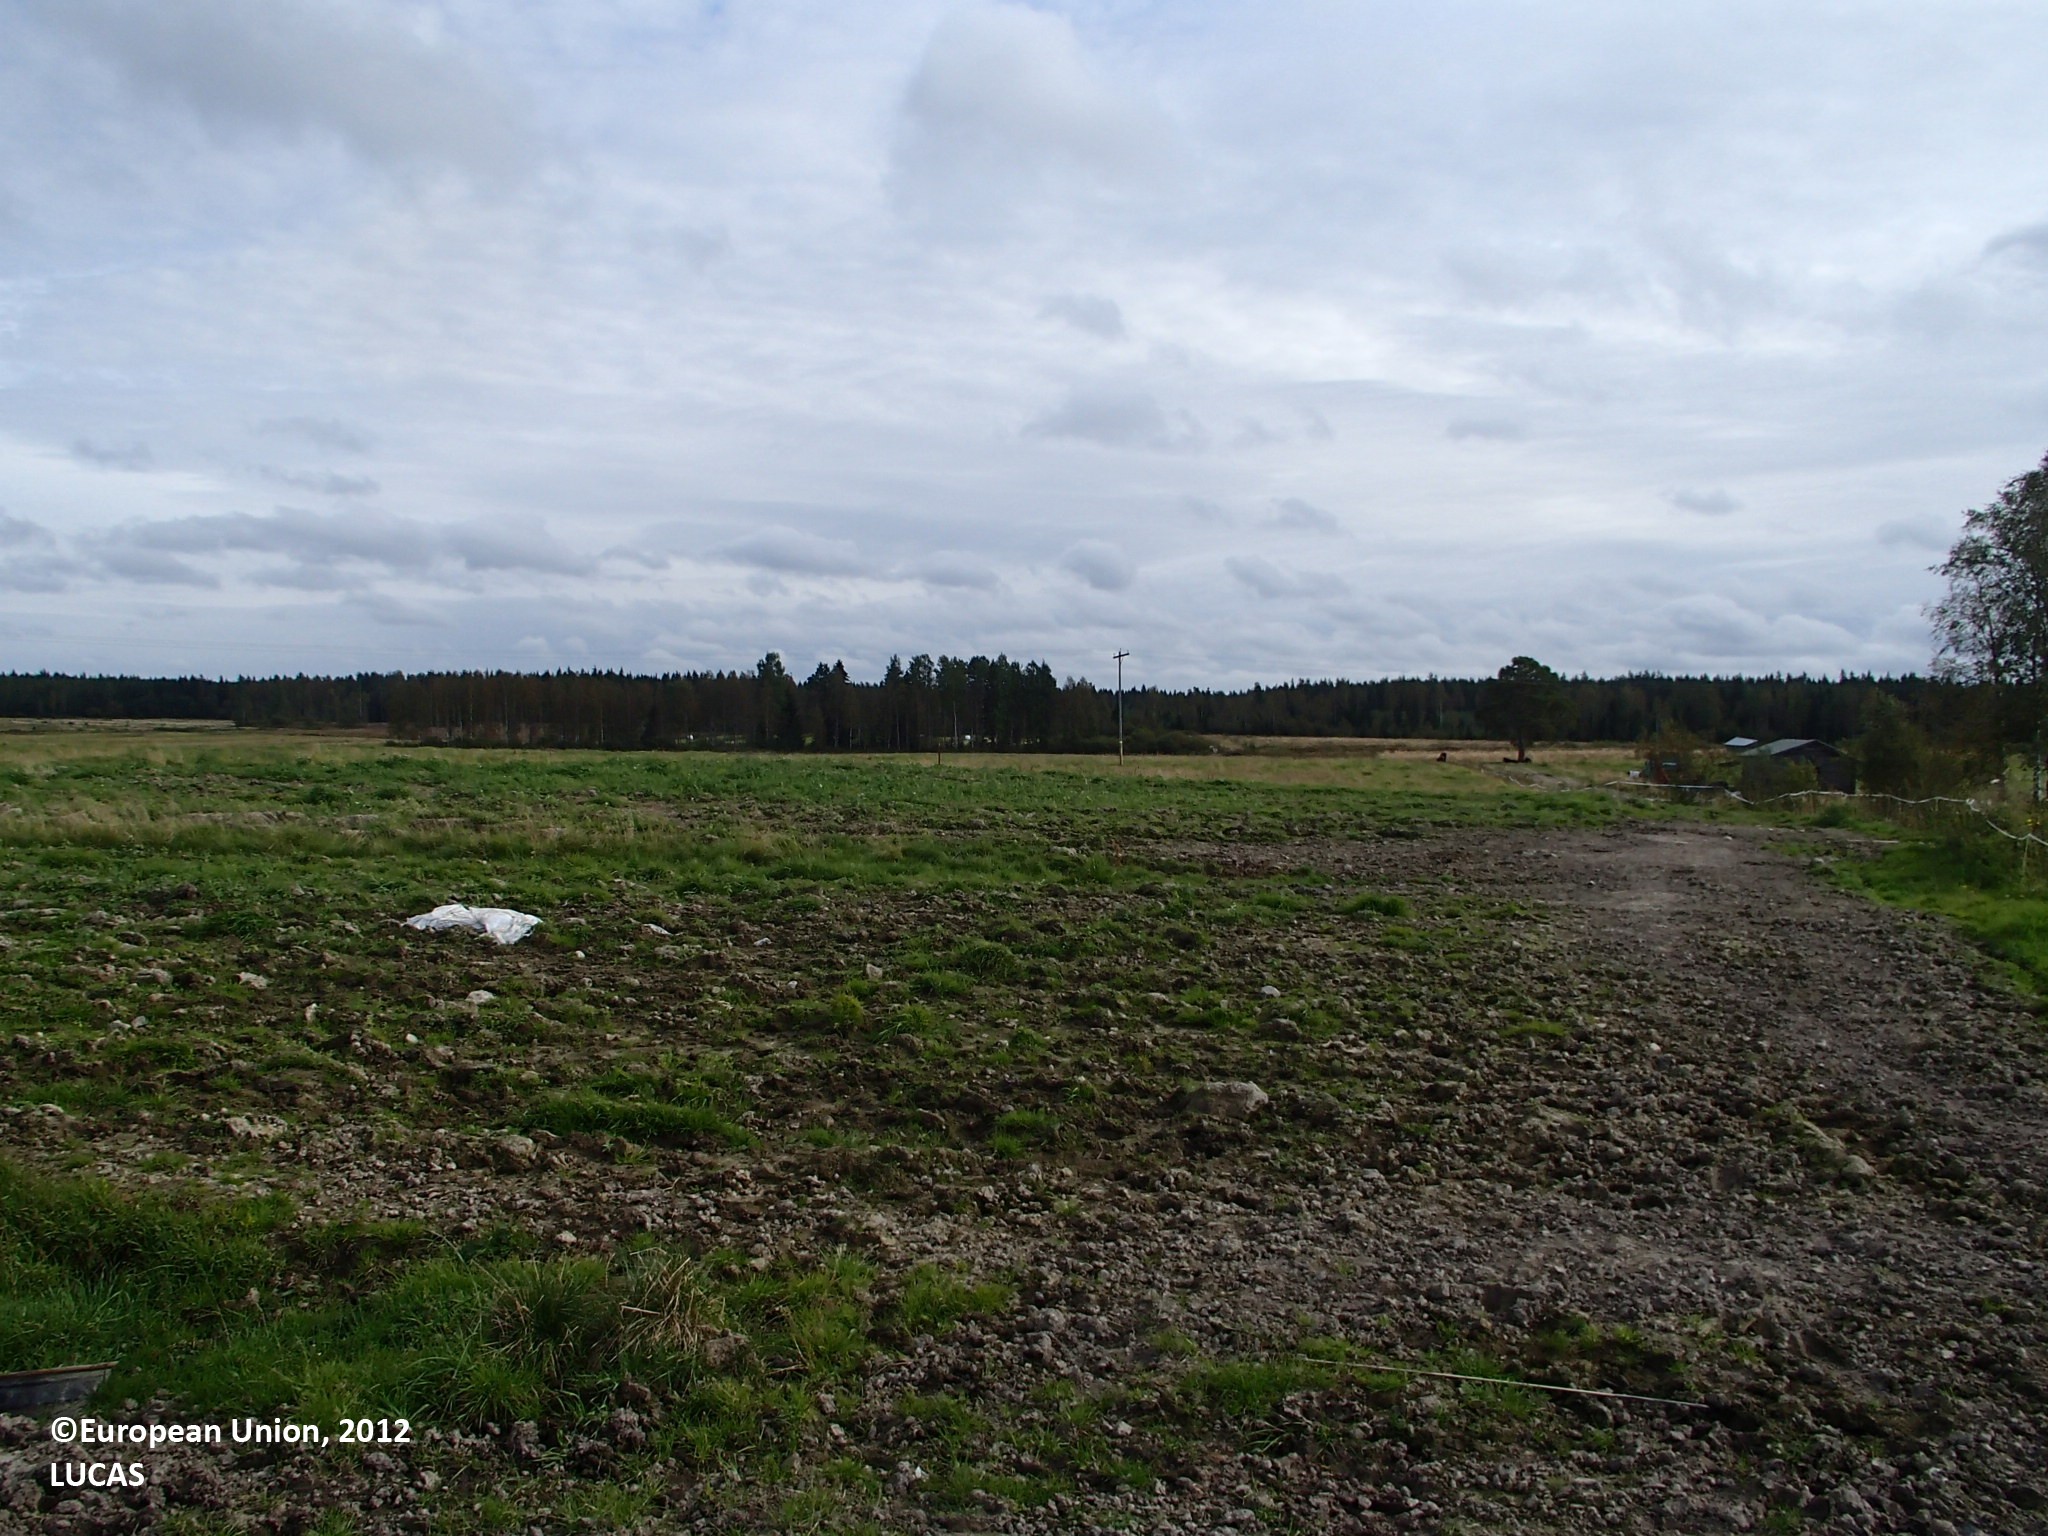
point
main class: Cropland
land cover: Temporary grasslands
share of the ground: > 75 %
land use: Agriculture (excluding fallow land and kitchen gardens)
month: September
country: FI
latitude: 63.7864
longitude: 25.9566
